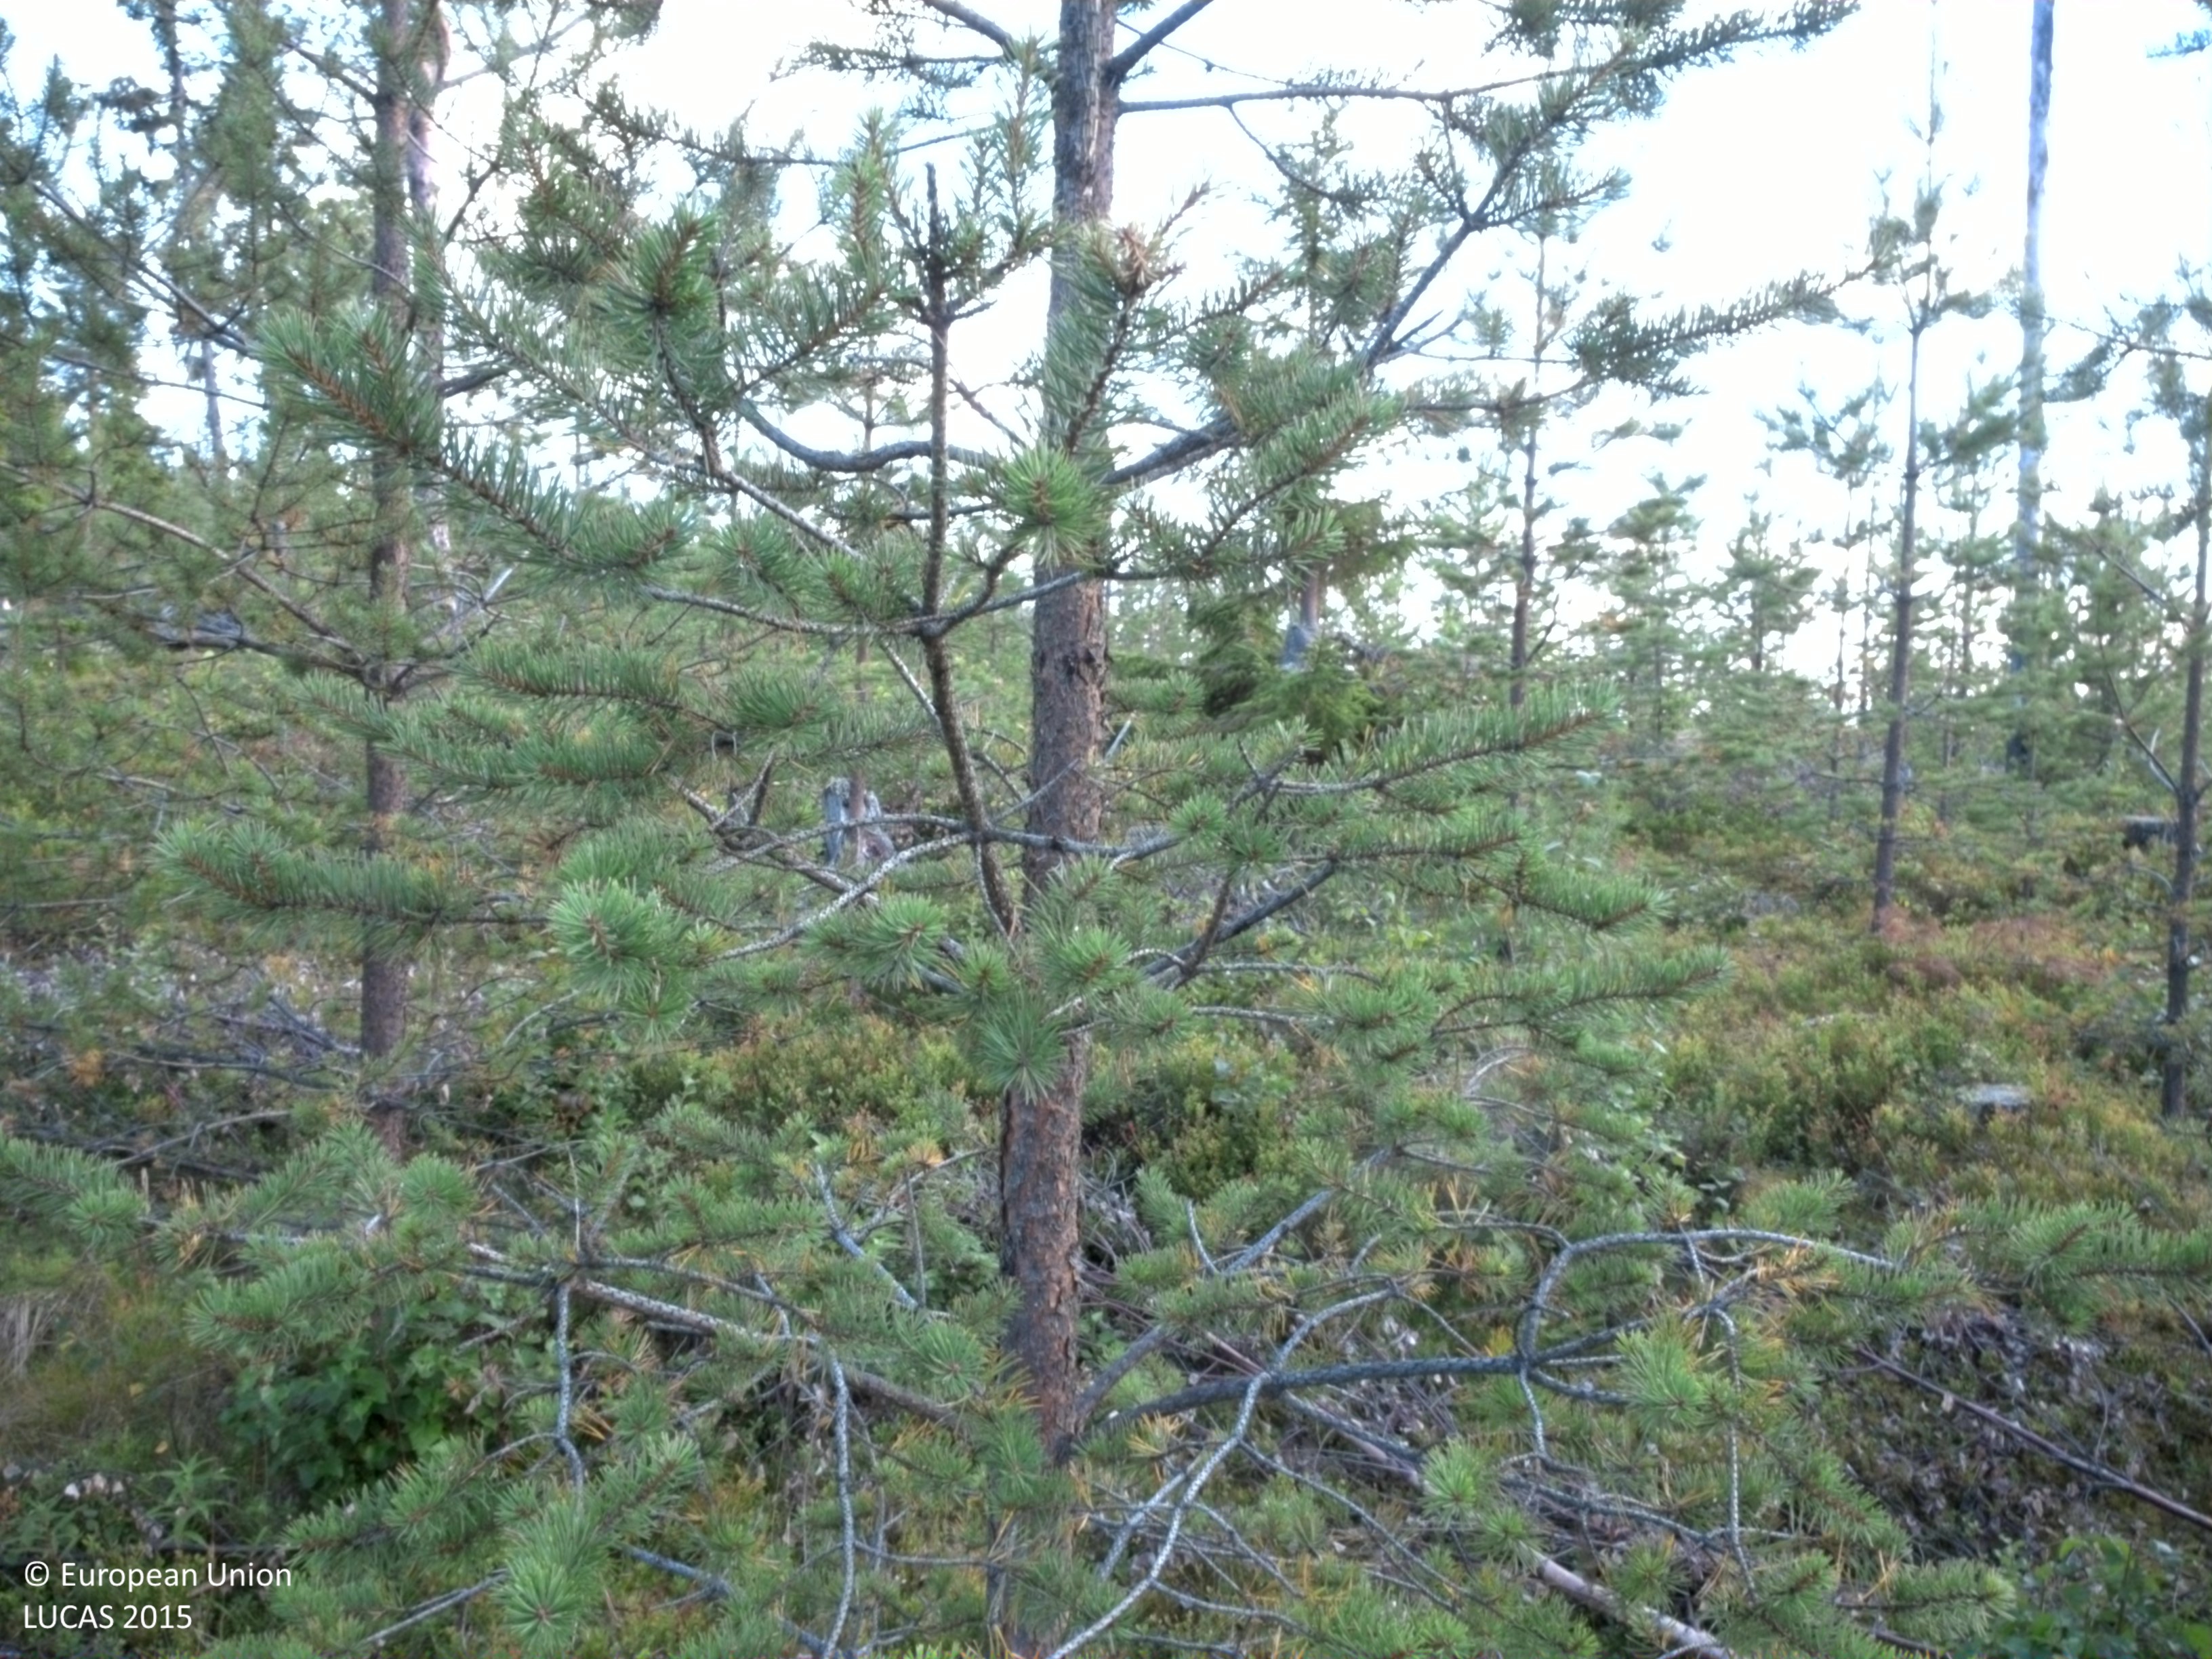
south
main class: Woodland
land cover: Pine dominated coniferous woodland
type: boreal forest
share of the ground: 25 - 50 %
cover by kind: coniferous forest trees 50 %, shrubs 40 %, lichens and mosses 10 %
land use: Forestry
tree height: < 5 m
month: August
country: SE
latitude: 64.3888
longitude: 18.8236
